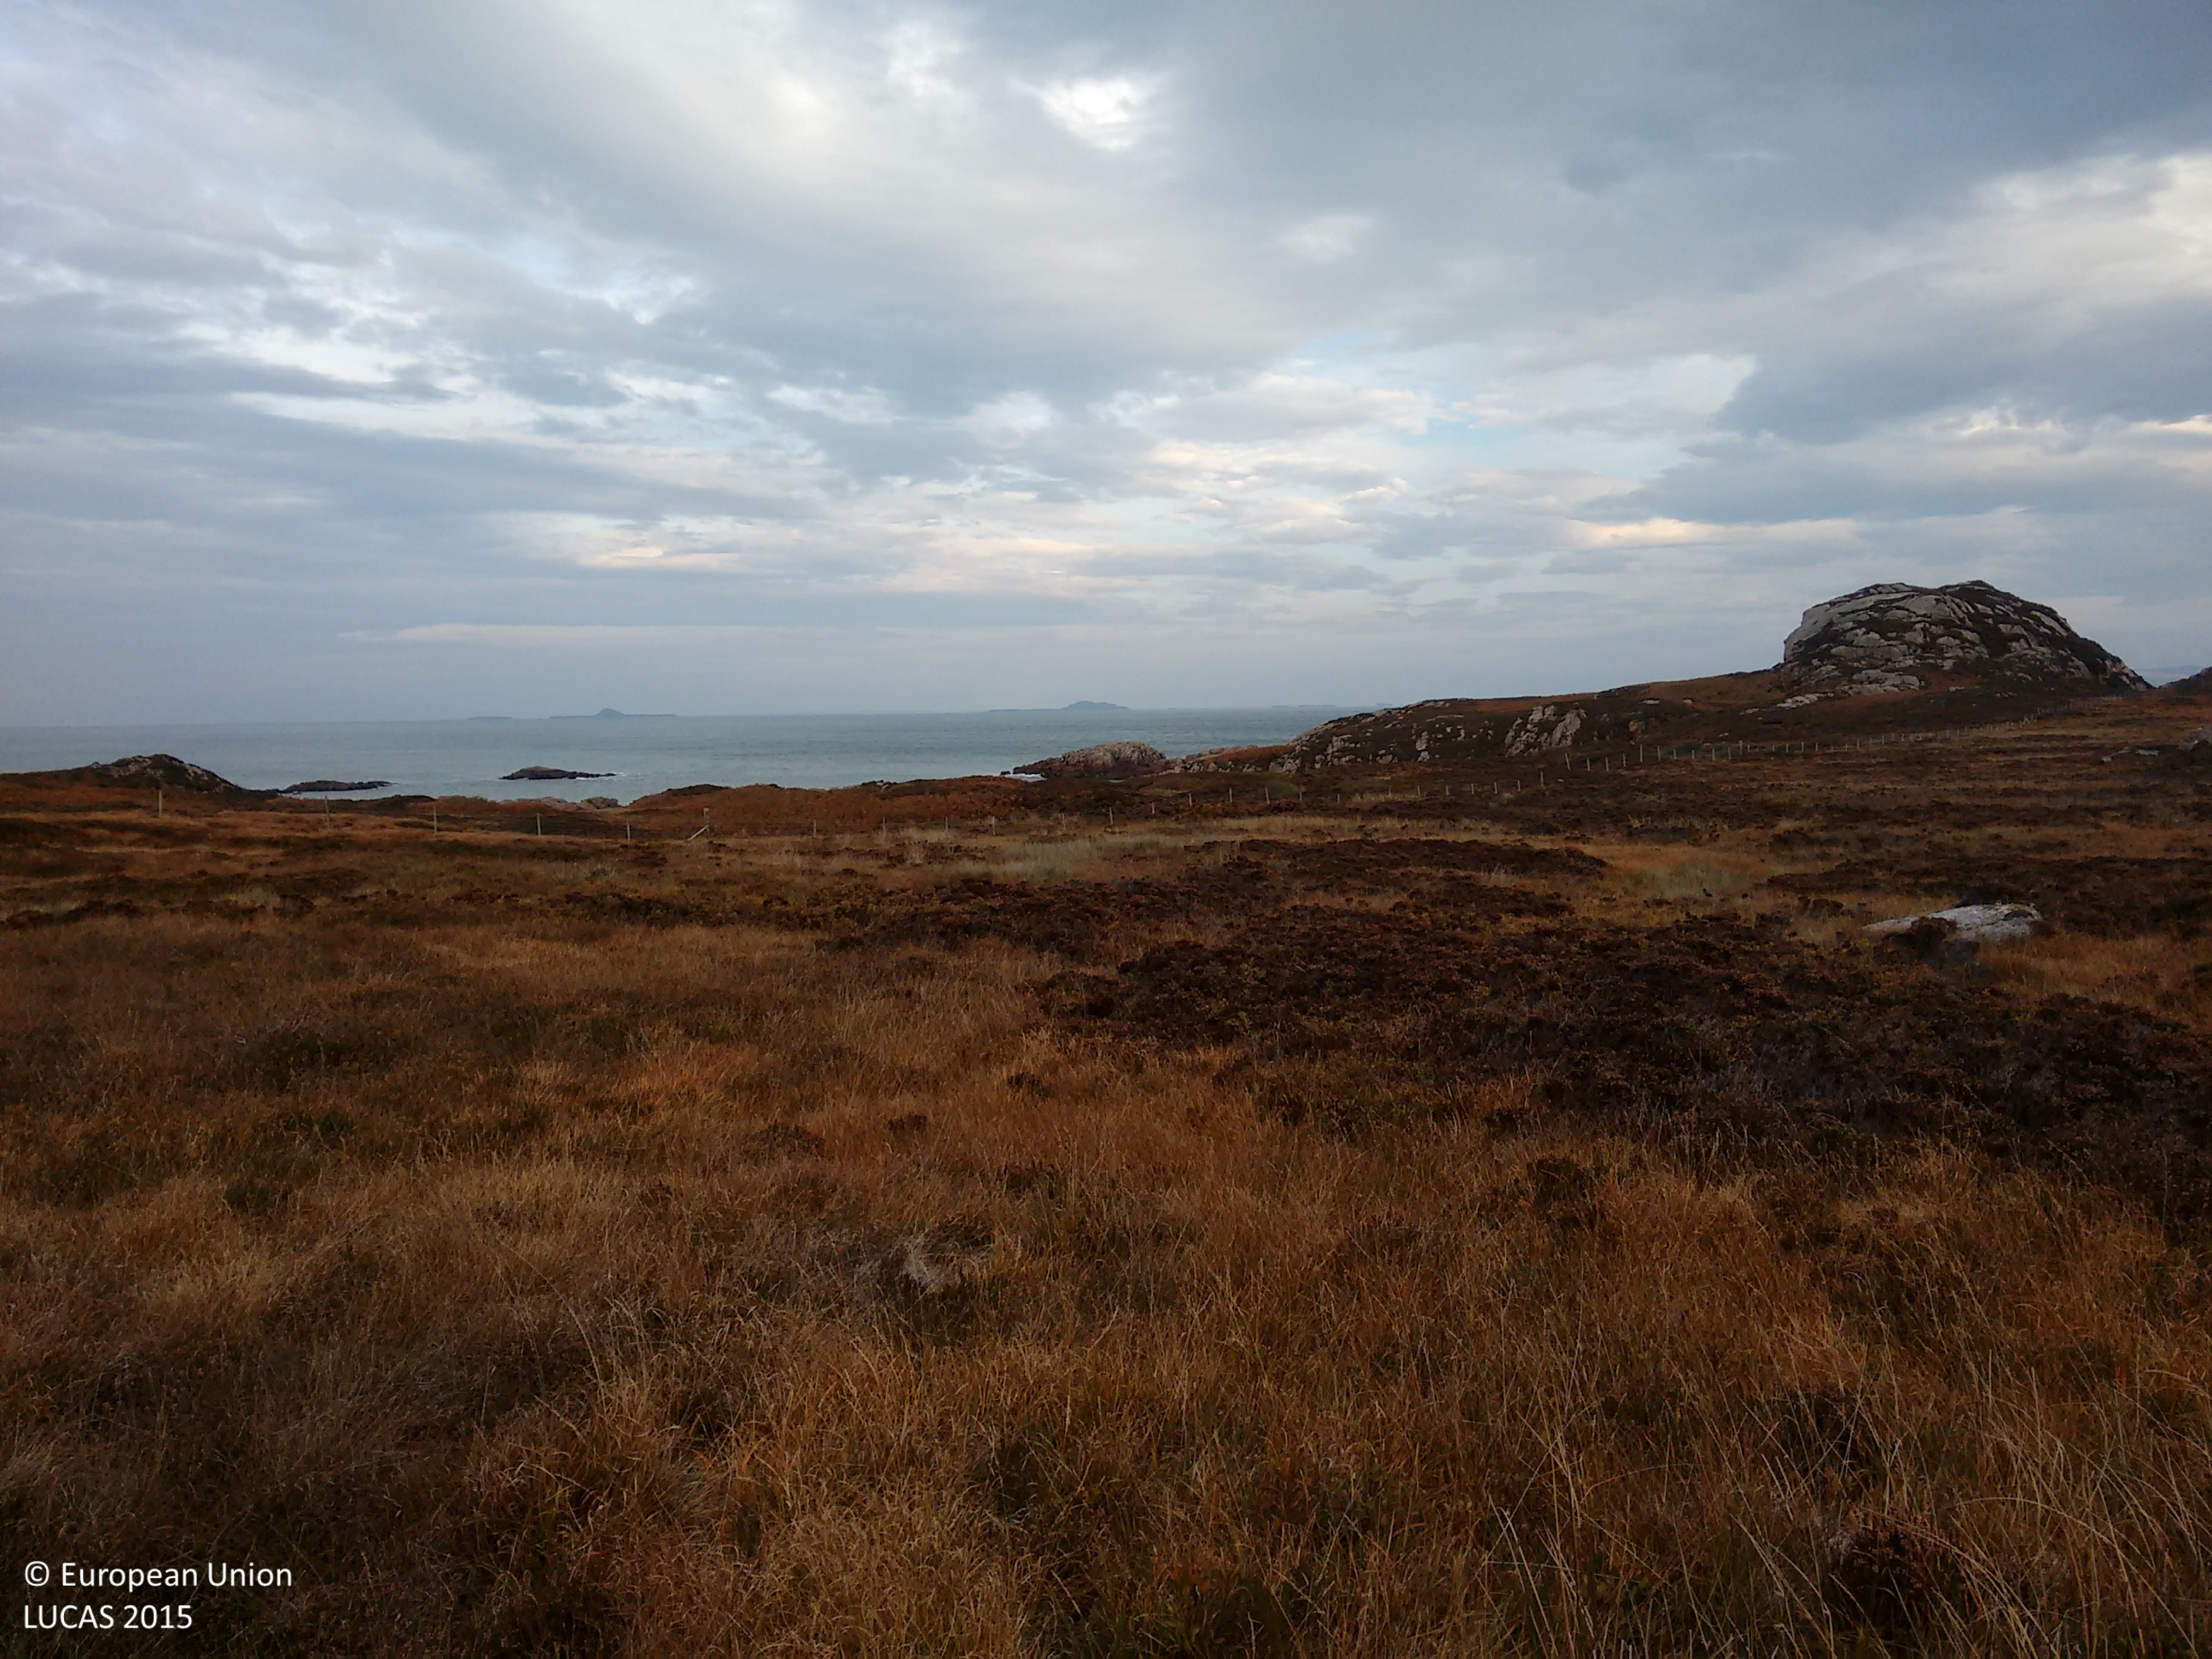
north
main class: Shrubland
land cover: Shrubland without tree cover
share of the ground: > 75 %
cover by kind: shrubs 40 %, herbaceous plants 30 %, lichens and mosses 30 %
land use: Semi-natural and natural areas not in use
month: October
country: GB
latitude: 56.3438
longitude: -6.3389
